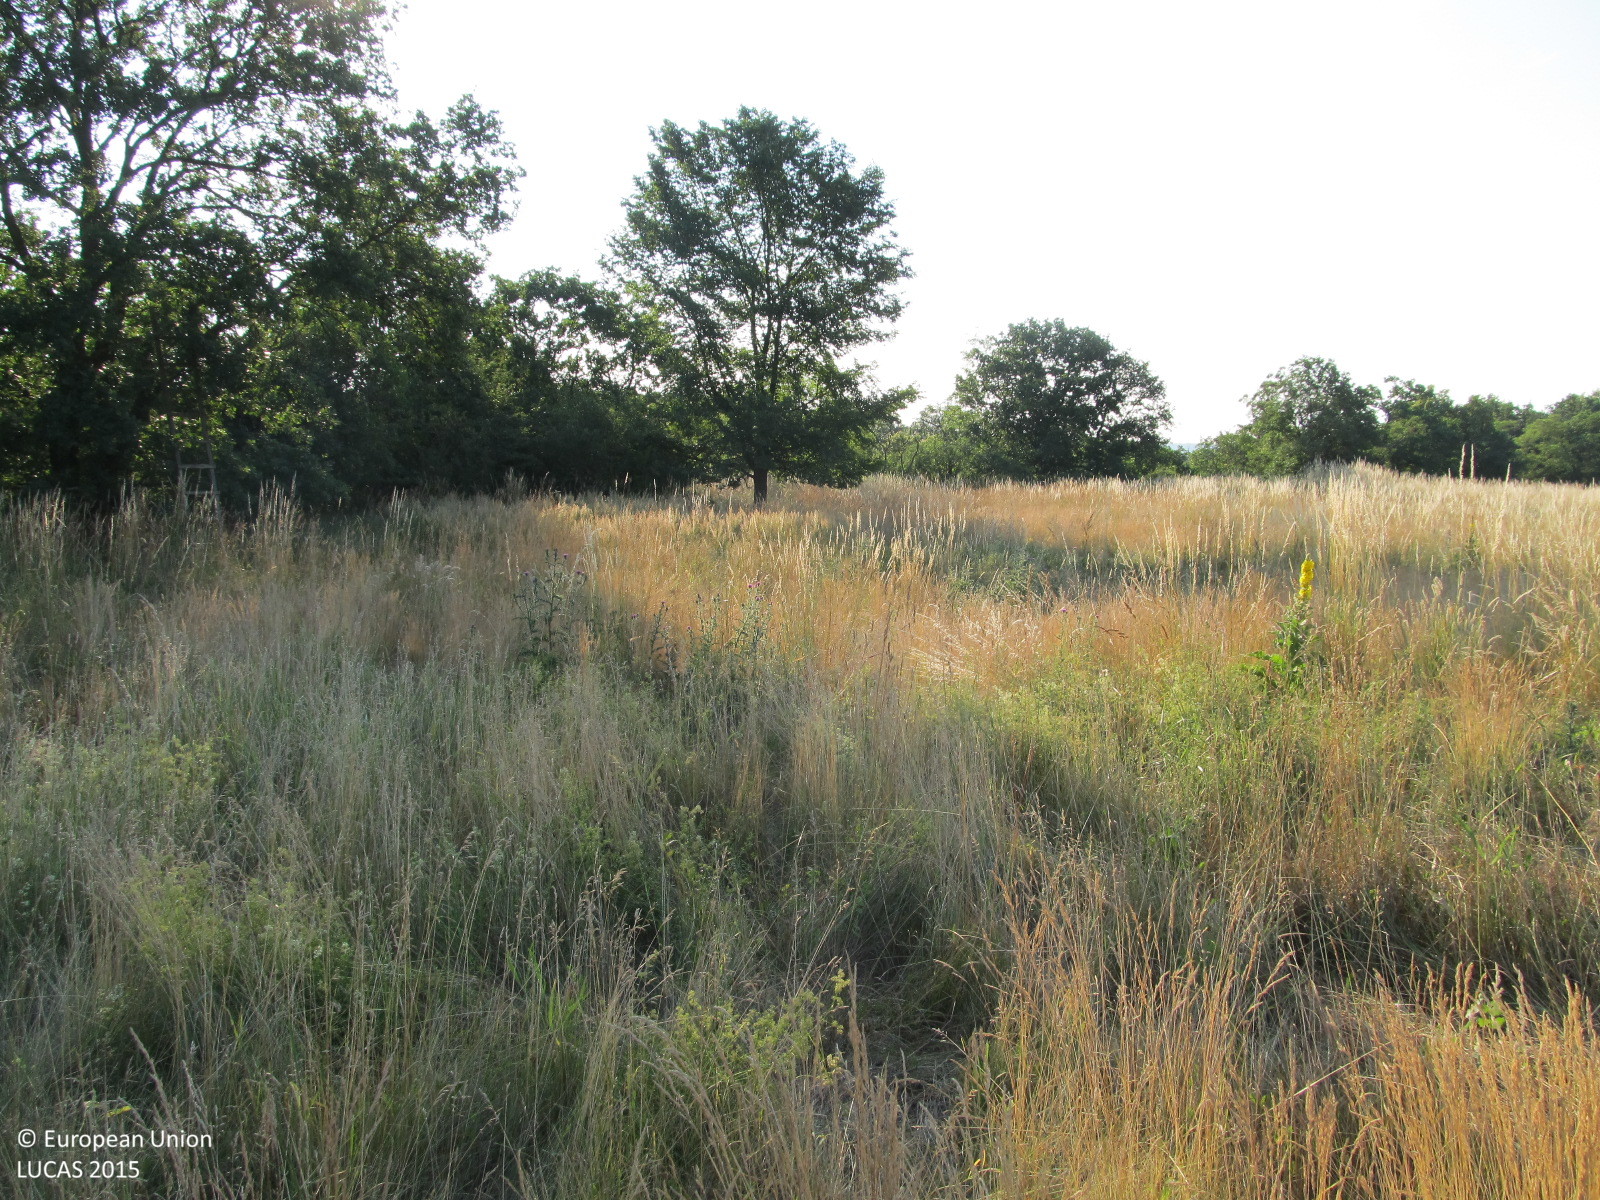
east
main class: Grassland
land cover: Grassland without tree/shrub cover
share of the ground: > 75 %
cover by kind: herbaceous plants 100 %
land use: Agriculture (excluding fallow land and kitchen gardens)
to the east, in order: Grassland without tree/shrub cover; Pine dominated mixed woodland; Broadleaved woodland; Inland fresh running water; Broadleaved woodland; Inland fresh running water; Broadleaved woodland
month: July
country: AT
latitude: 48.6551
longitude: 15.6643
